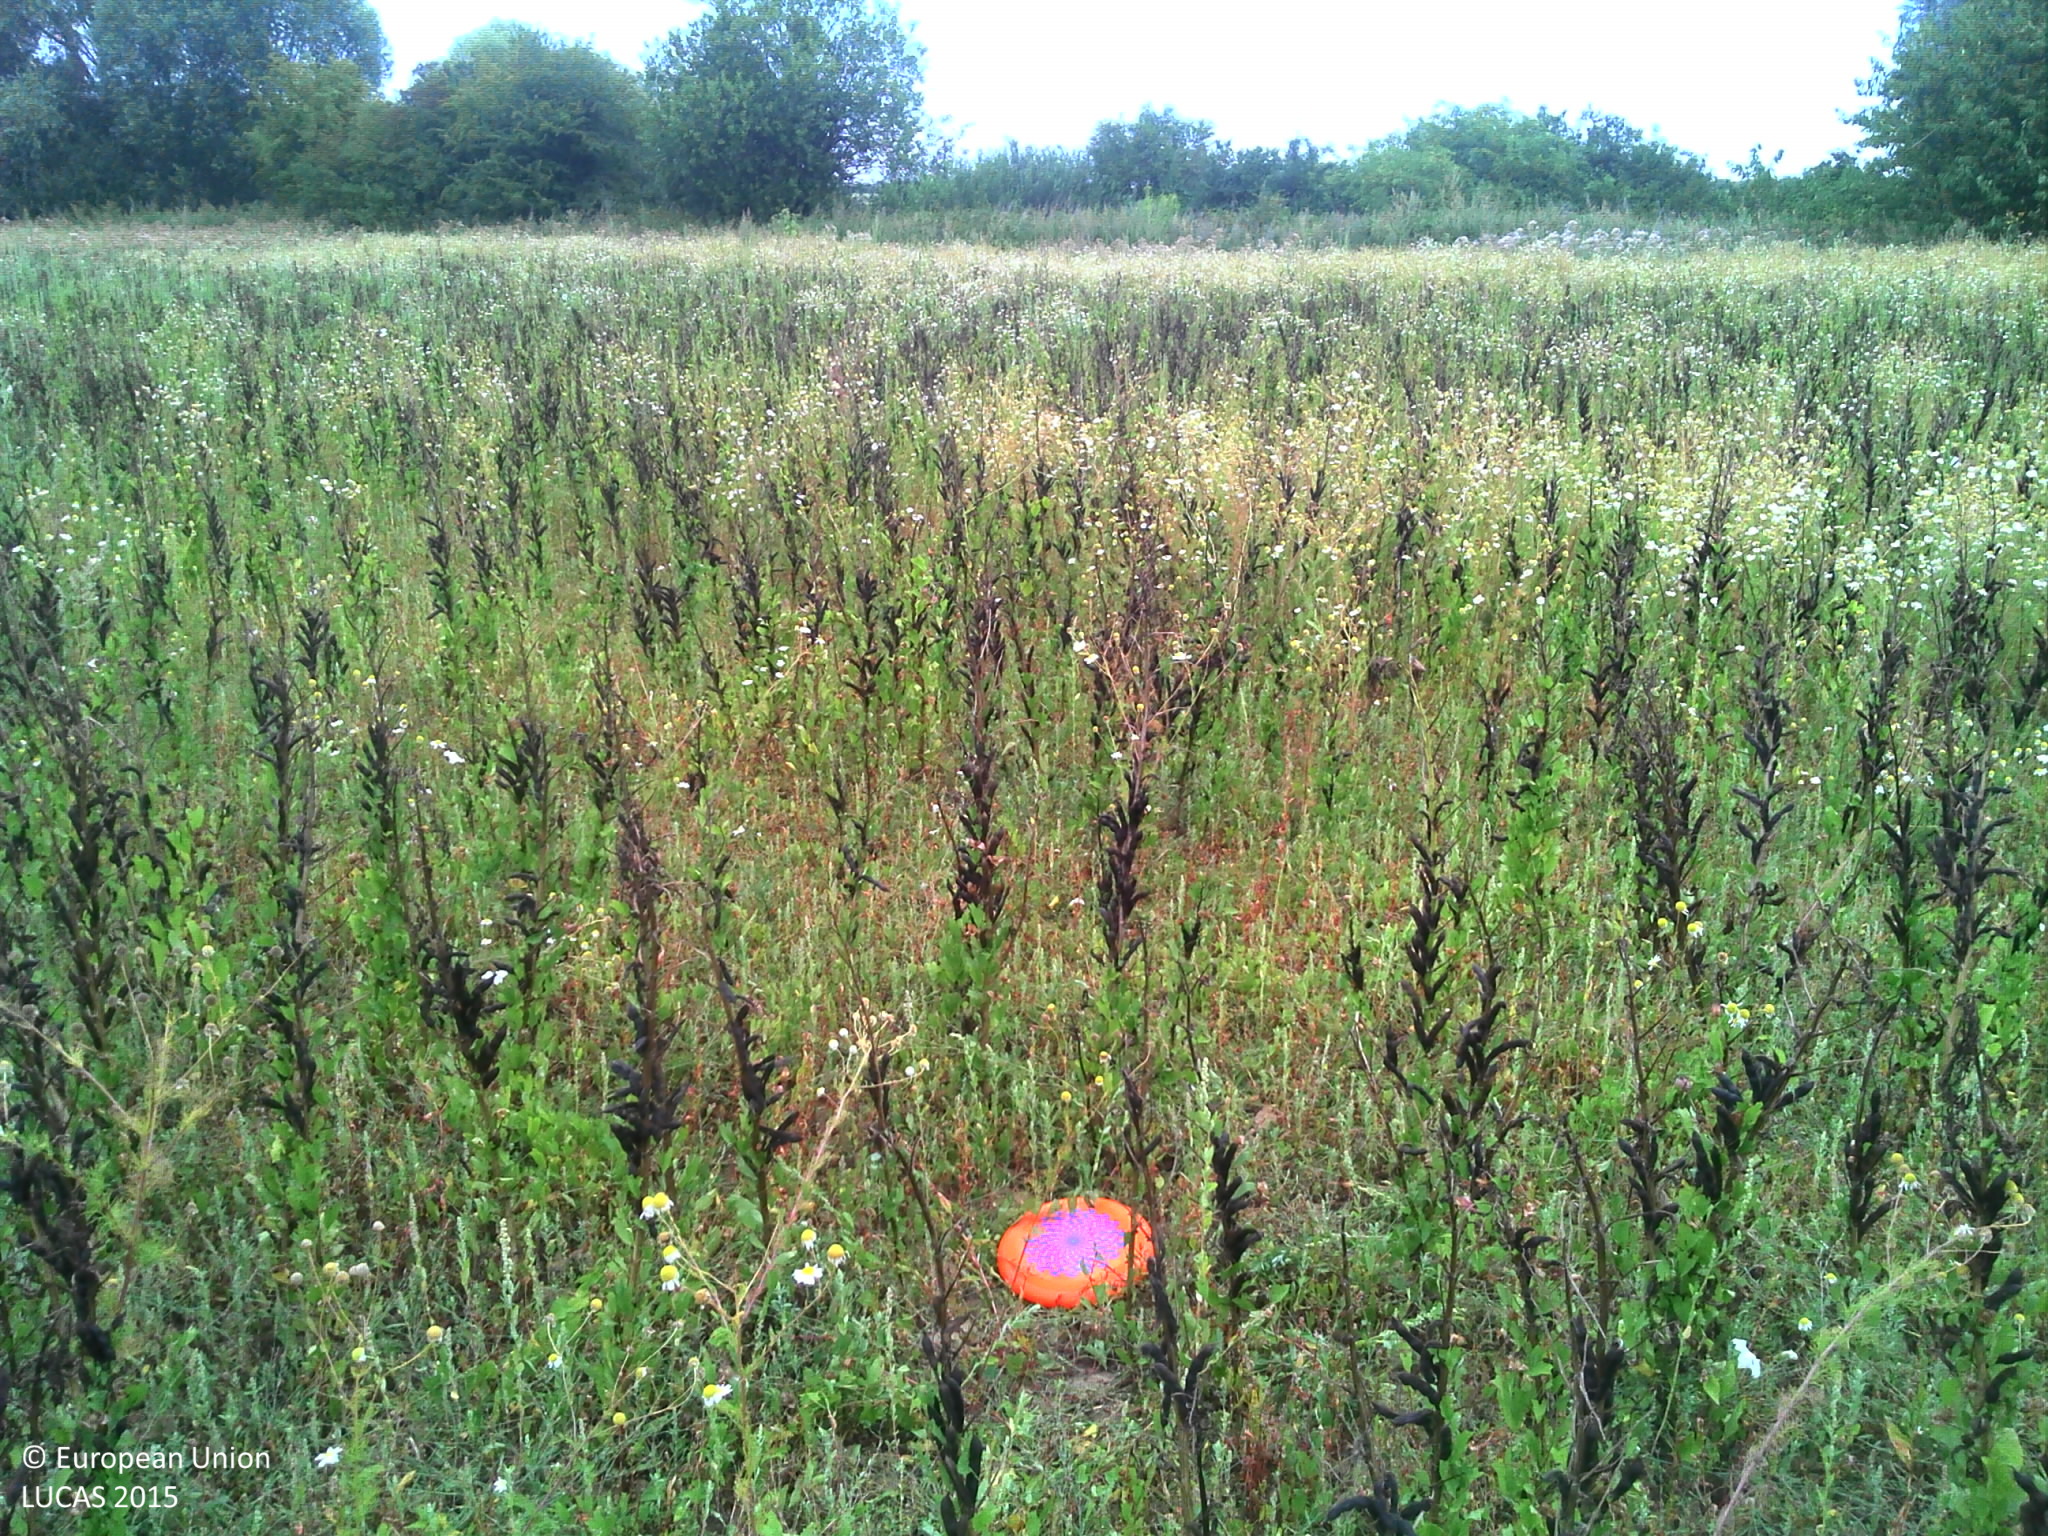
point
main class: Grassland
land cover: Spontaneously vegetated surfaces
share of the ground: > 75 %
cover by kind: herbaceous plants 100 %
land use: Fallow land
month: August
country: FR
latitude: 48.7124
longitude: 2.5552
